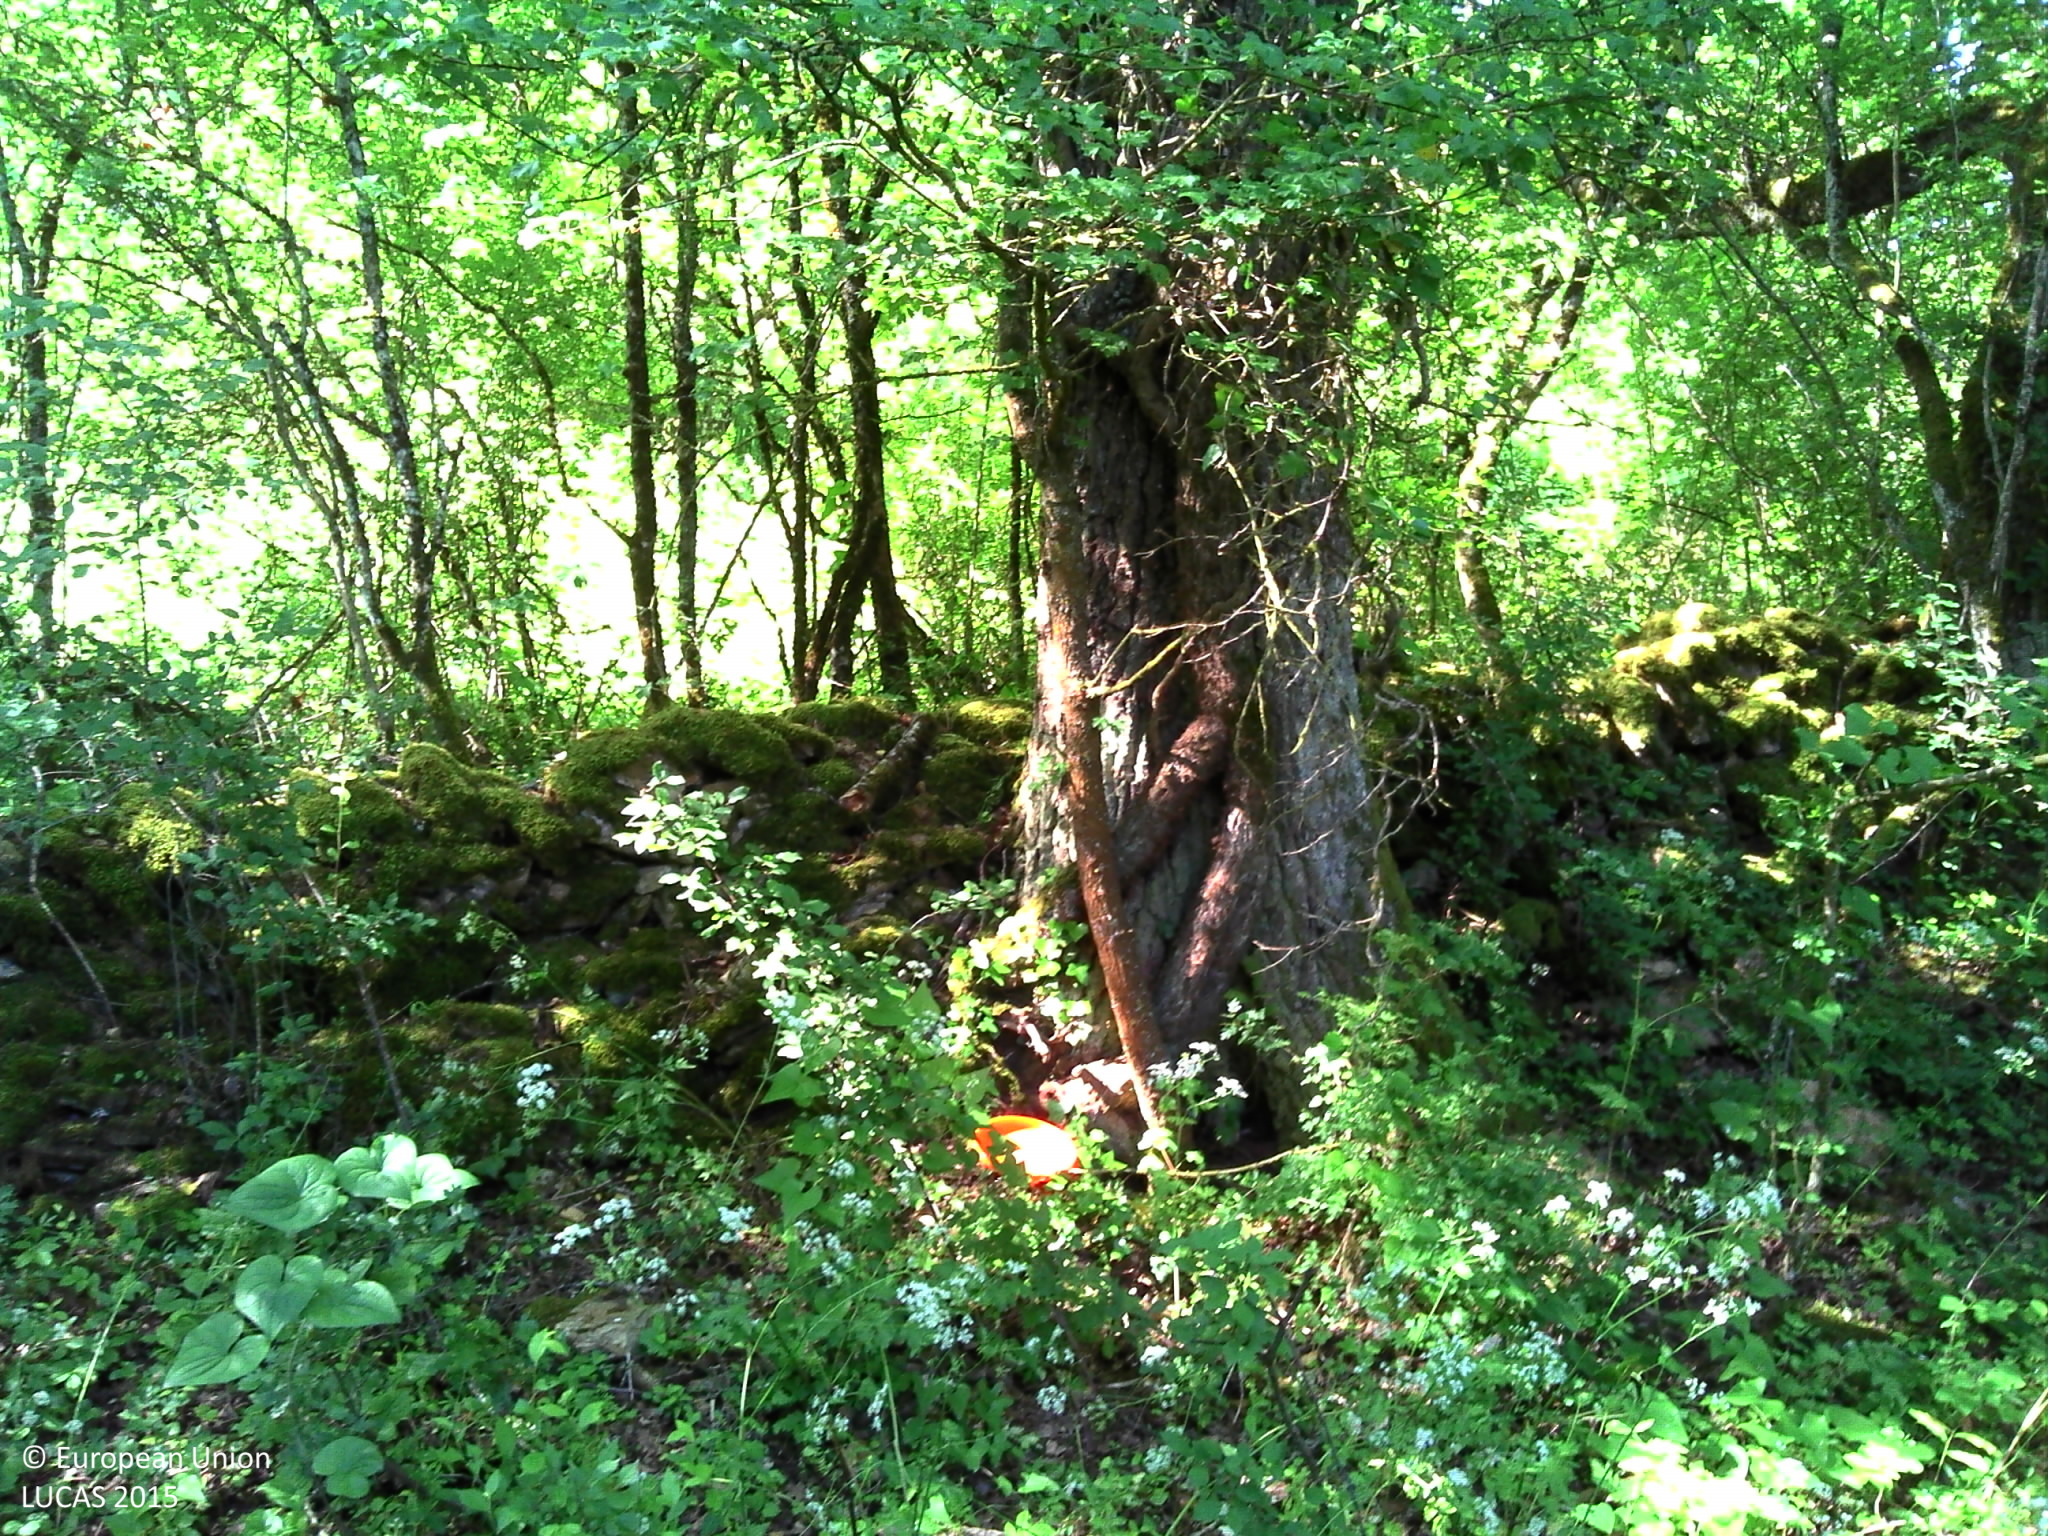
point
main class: Woodland
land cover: Broadleaved woodland
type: acidophilous oak and oak-birch forest
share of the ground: > 75 %
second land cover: Grassland without tree/shrub cover
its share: 50 - 75 %
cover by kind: broadleaved forest trees 60 %, herbaceous plants 35 %, lichens and mosses 5 %
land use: Forestry
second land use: Agriculture (excluding fallow land and kitchen gardens)
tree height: > 5 m
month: May
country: FR
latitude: 44.3910
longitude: 2.5589
